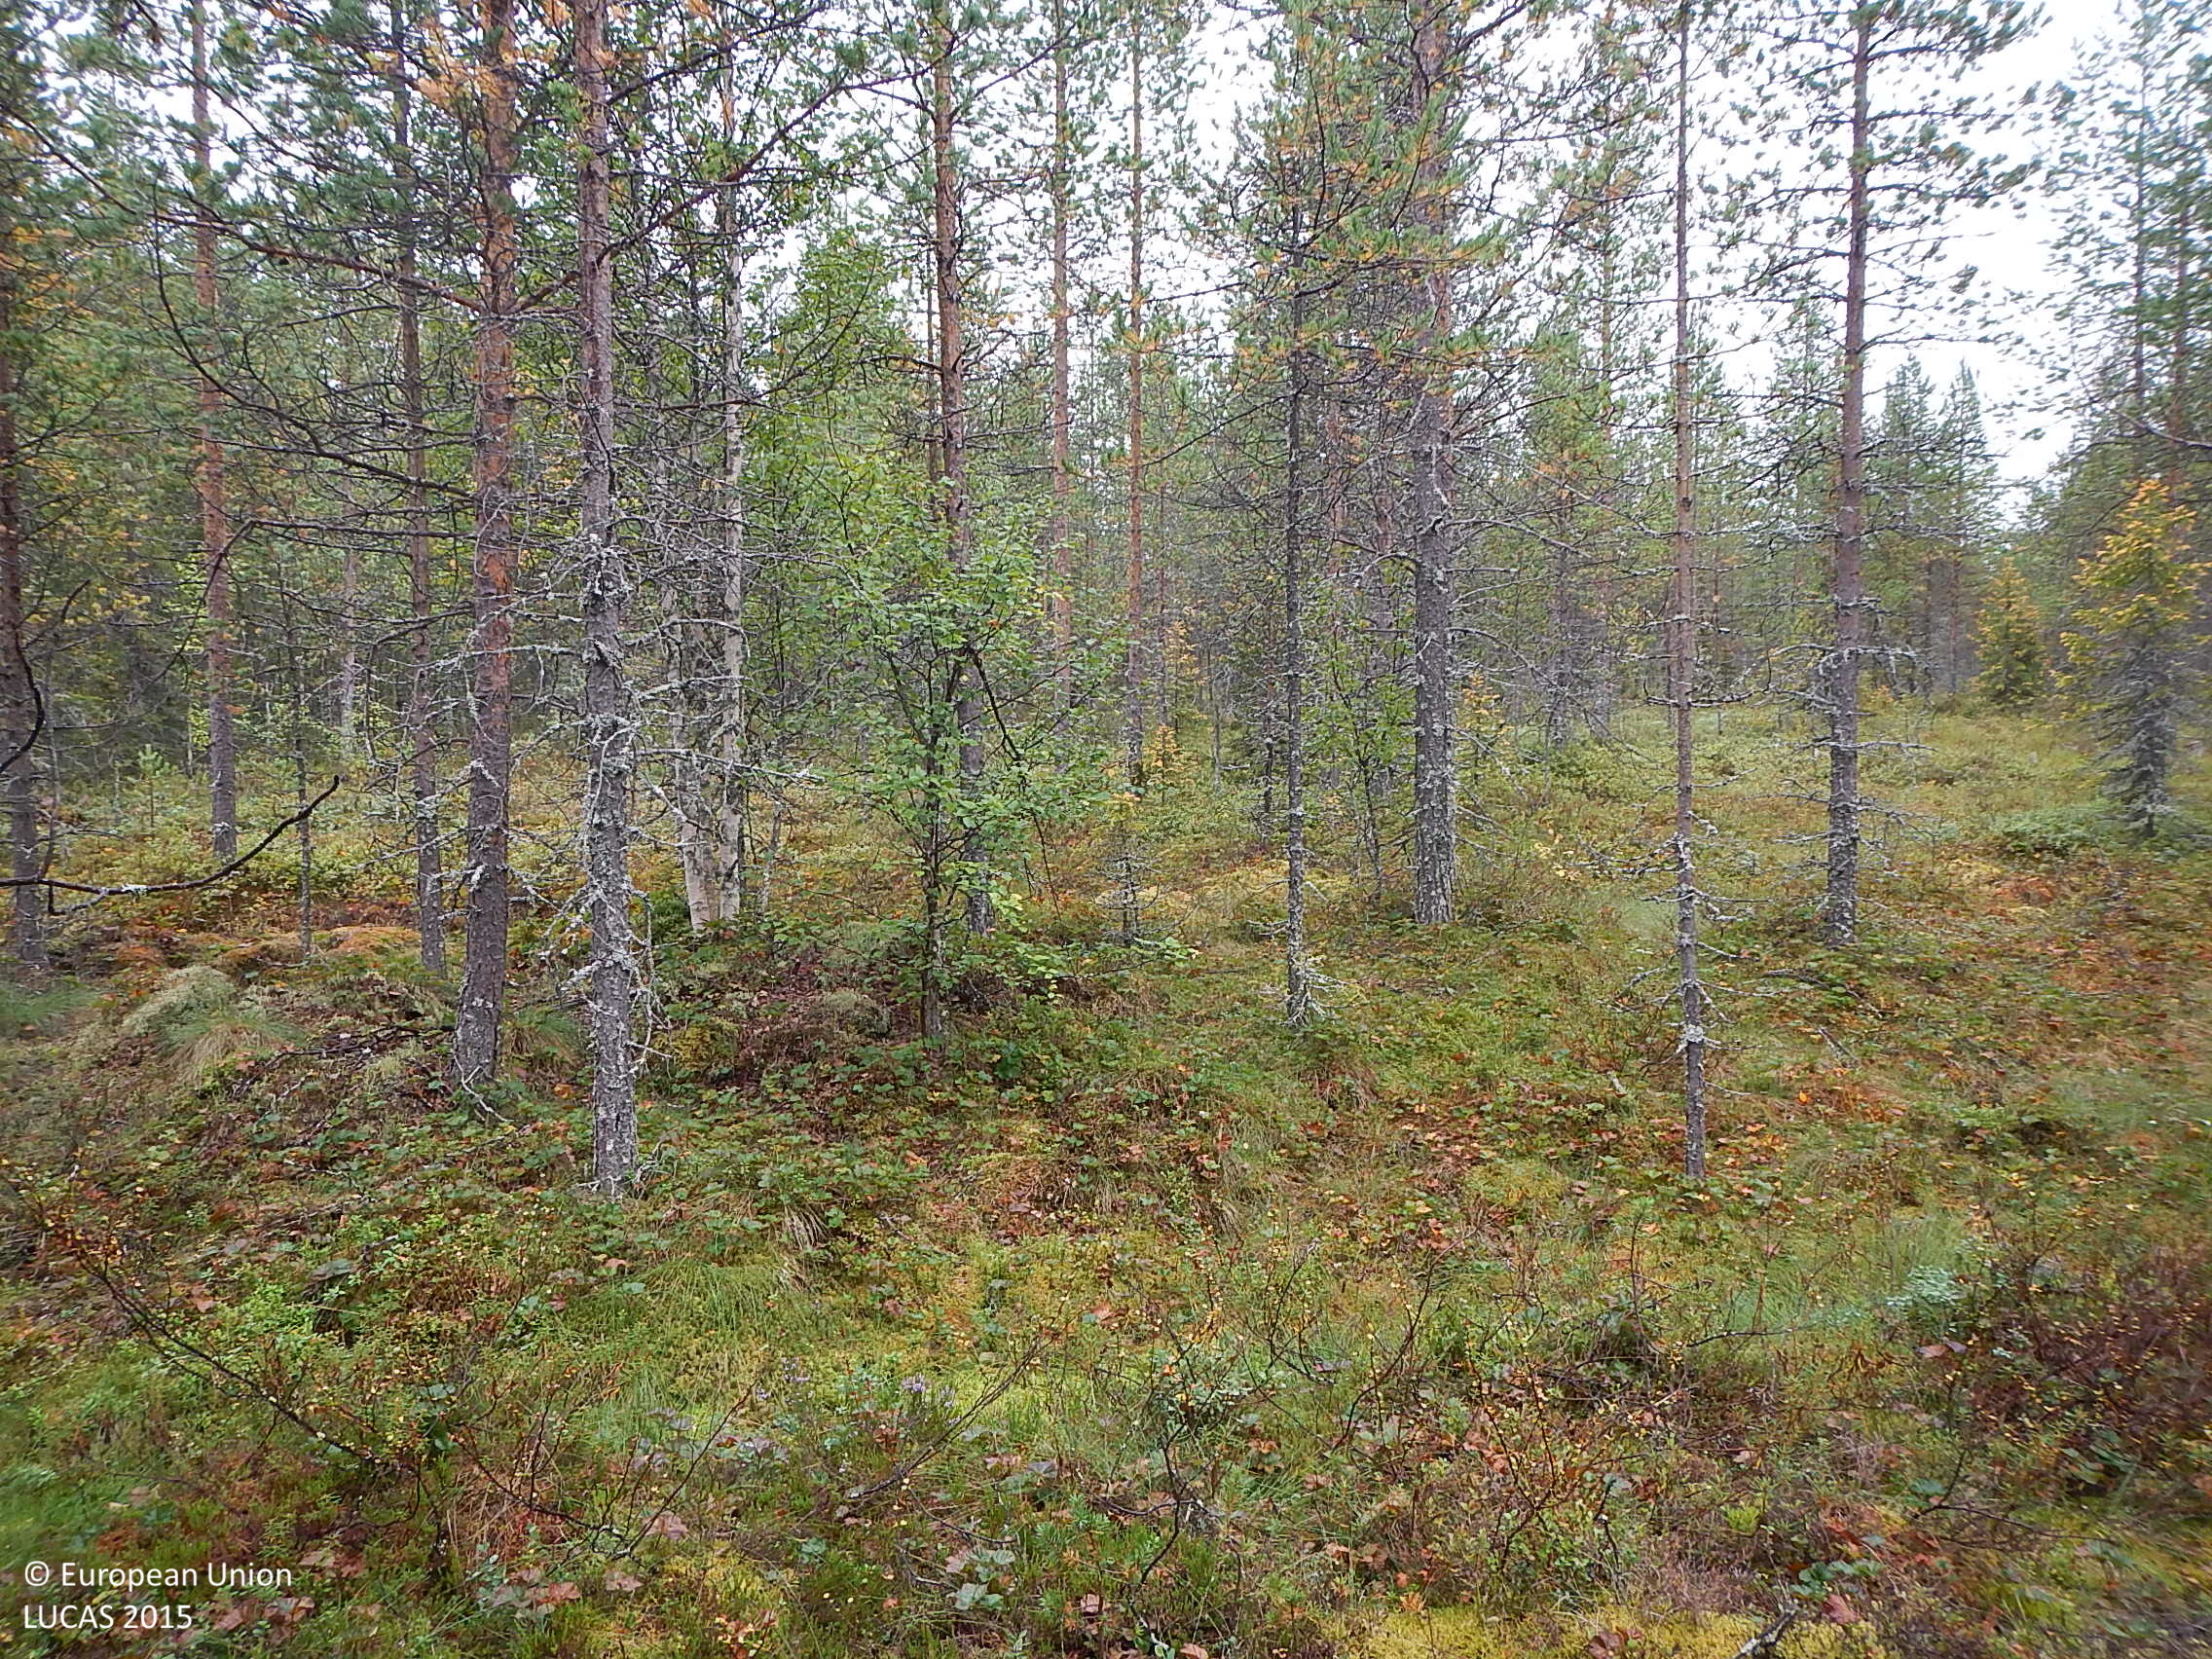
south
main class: Woodland
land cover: Pine dominated coniferous woodland
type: boreal forest
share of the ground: 50 - 75 %
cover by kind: coniferous forest trees 60 %, shrubs 30 %, broadleaved forest trees 5 %, herbaceous plants 5 %
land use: Forestry
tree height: > 5 m
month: August
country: FI
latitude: 65.9633
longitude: 27.3453
